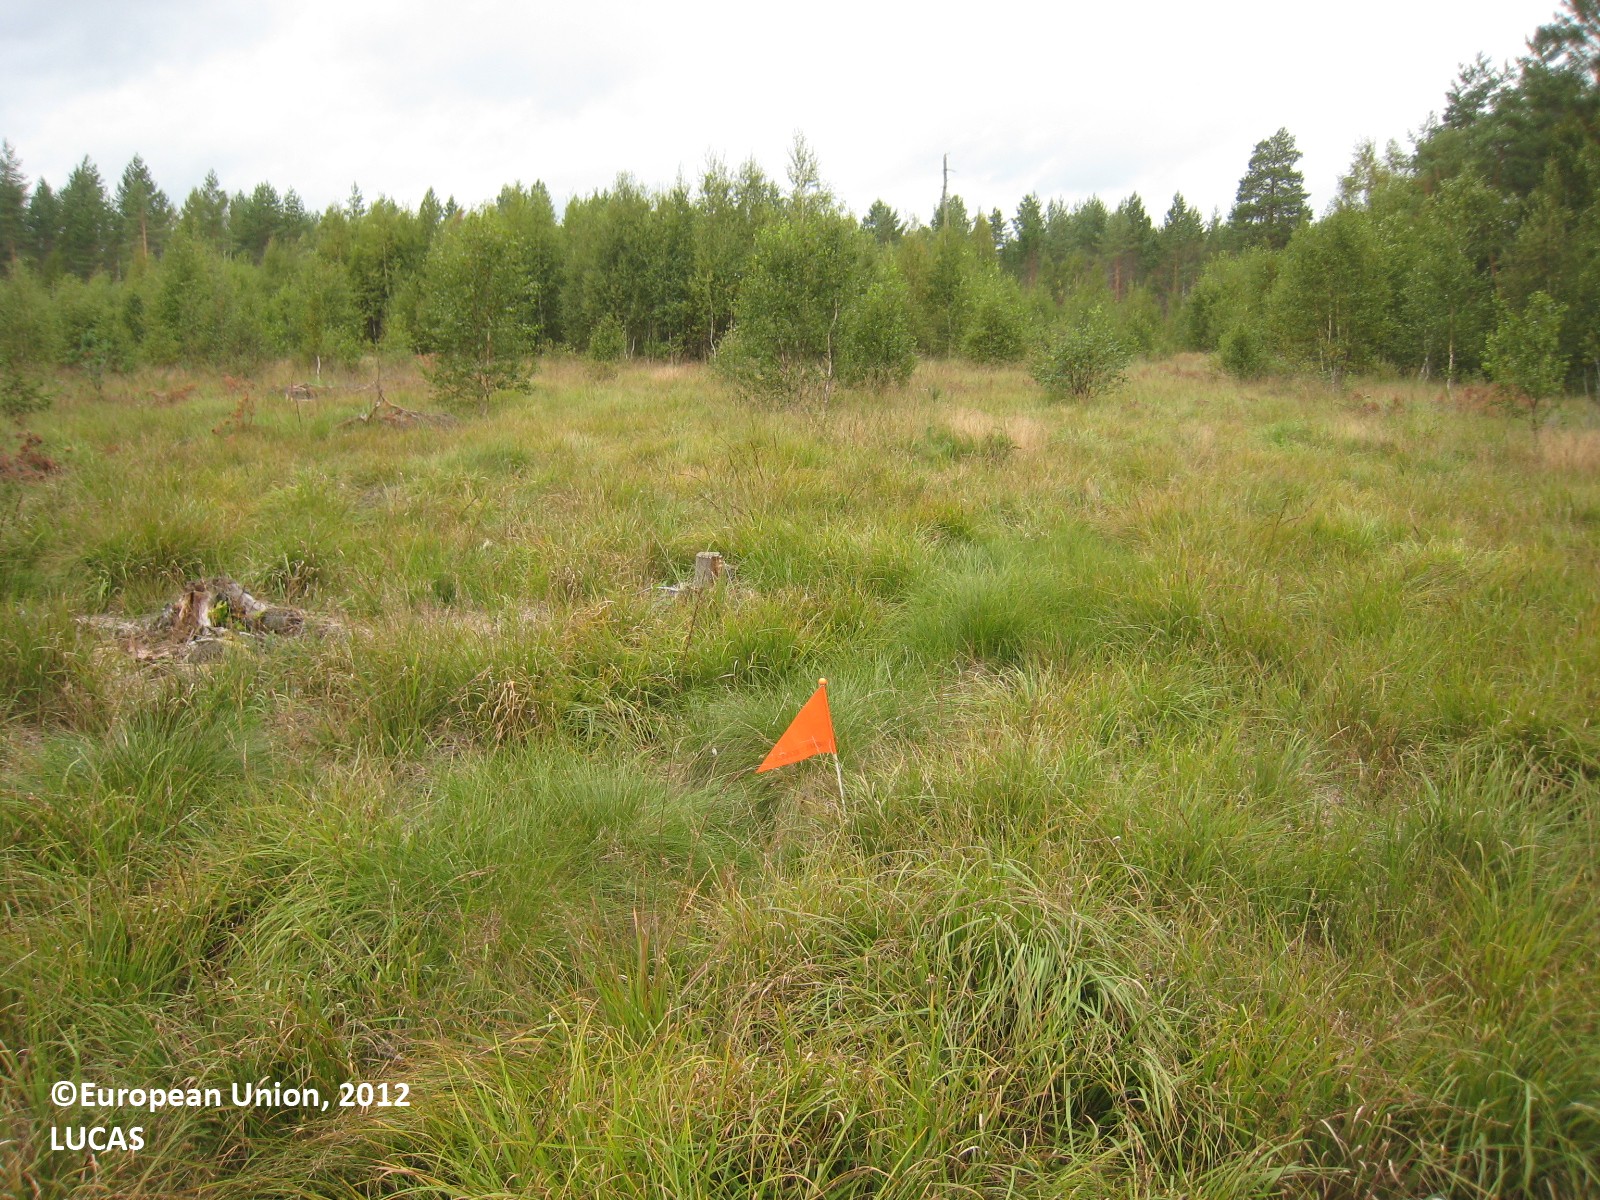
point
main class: Grassland
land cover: Grassland with sparse tree/shrub cover
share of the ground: > 75 %
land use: Forestry
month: August
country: FI
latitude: 61.8548
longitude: 26.0373
